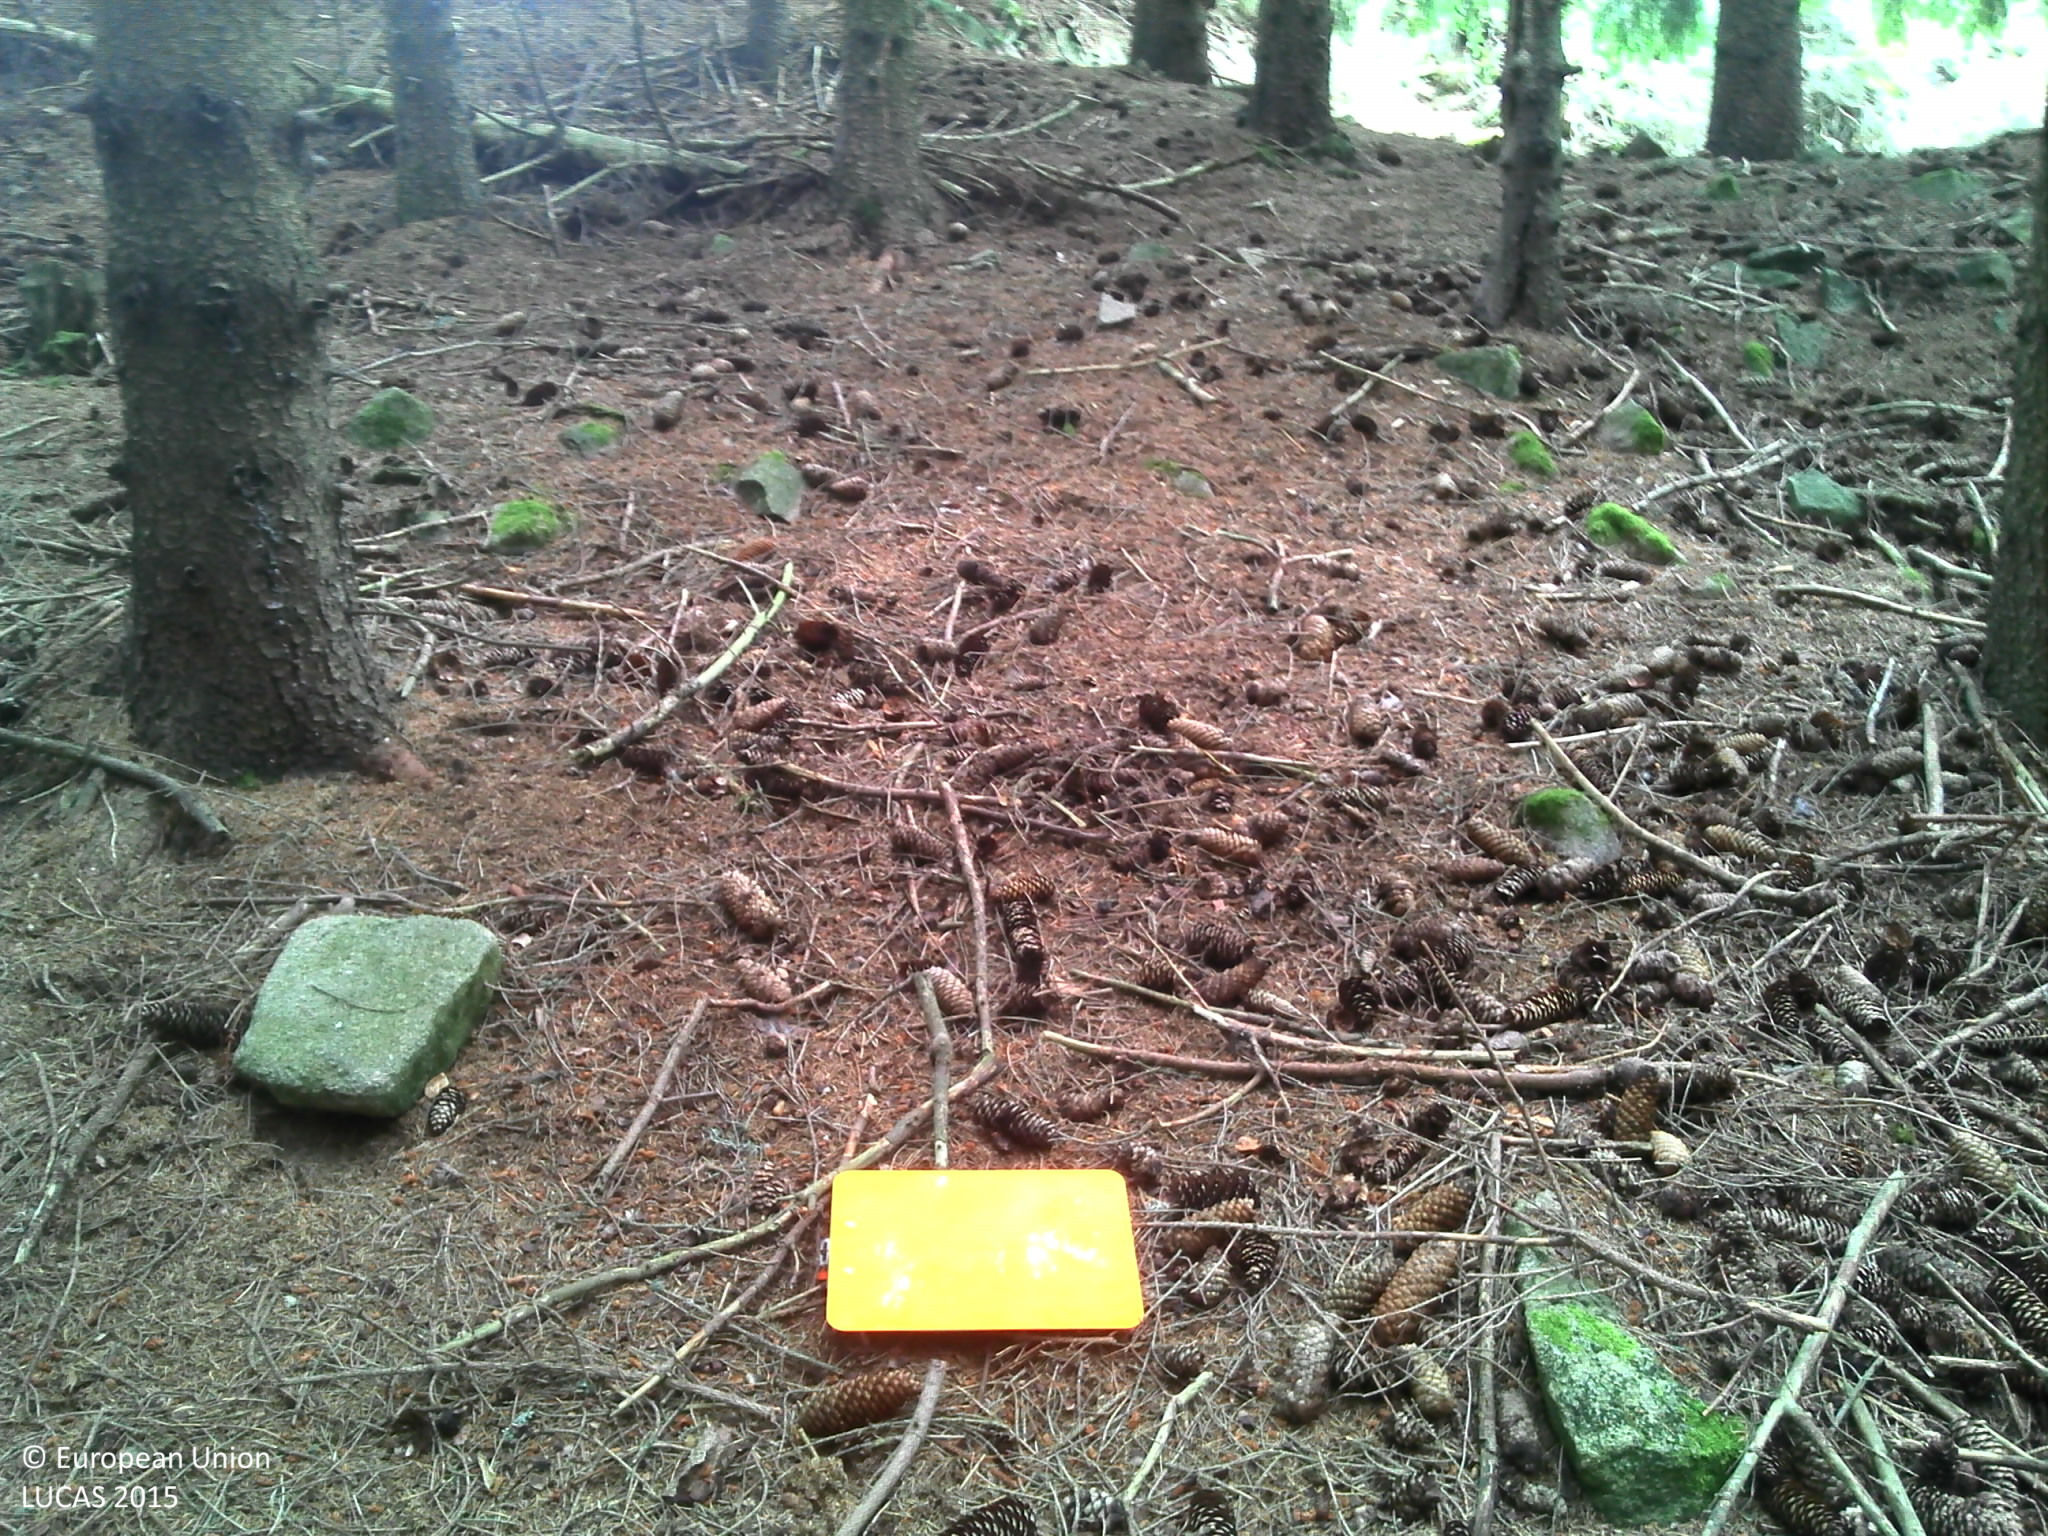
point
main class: Woodland
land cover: Spruce dominated coniferous woodland
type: alpine coniferous forest
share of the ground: > 75 %
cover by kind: coniferous forest trees 90 %, unconsolidated bare surface 10 %
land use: Forestry
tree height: > 5 m
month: September
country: FR
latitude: 44.8970
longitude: 4.2688
